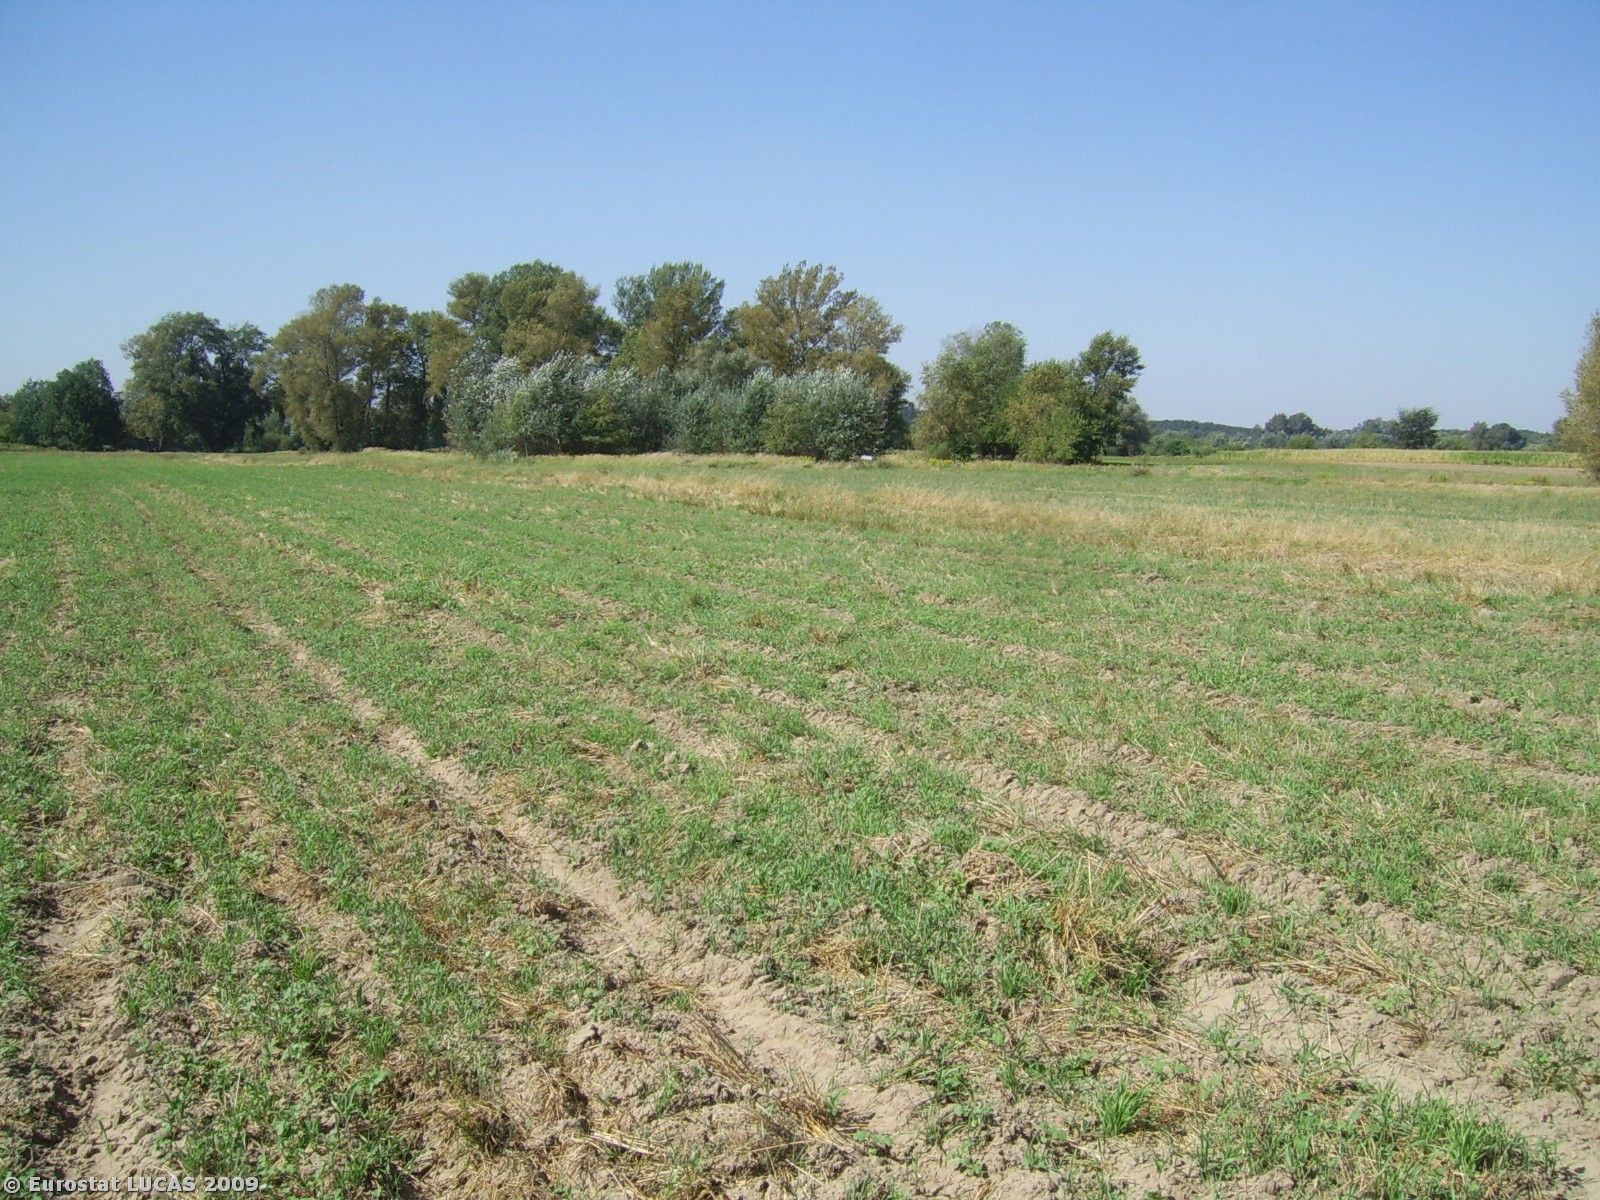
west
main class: Cropland
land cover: Other leguminous and mixtures for fodder
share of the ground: < 10 %
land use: Agriculture (excluding fallow land and kitchen gardens)
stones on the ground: < 10 %
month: September
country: PL
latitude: 52.9419
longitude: 18.7257
